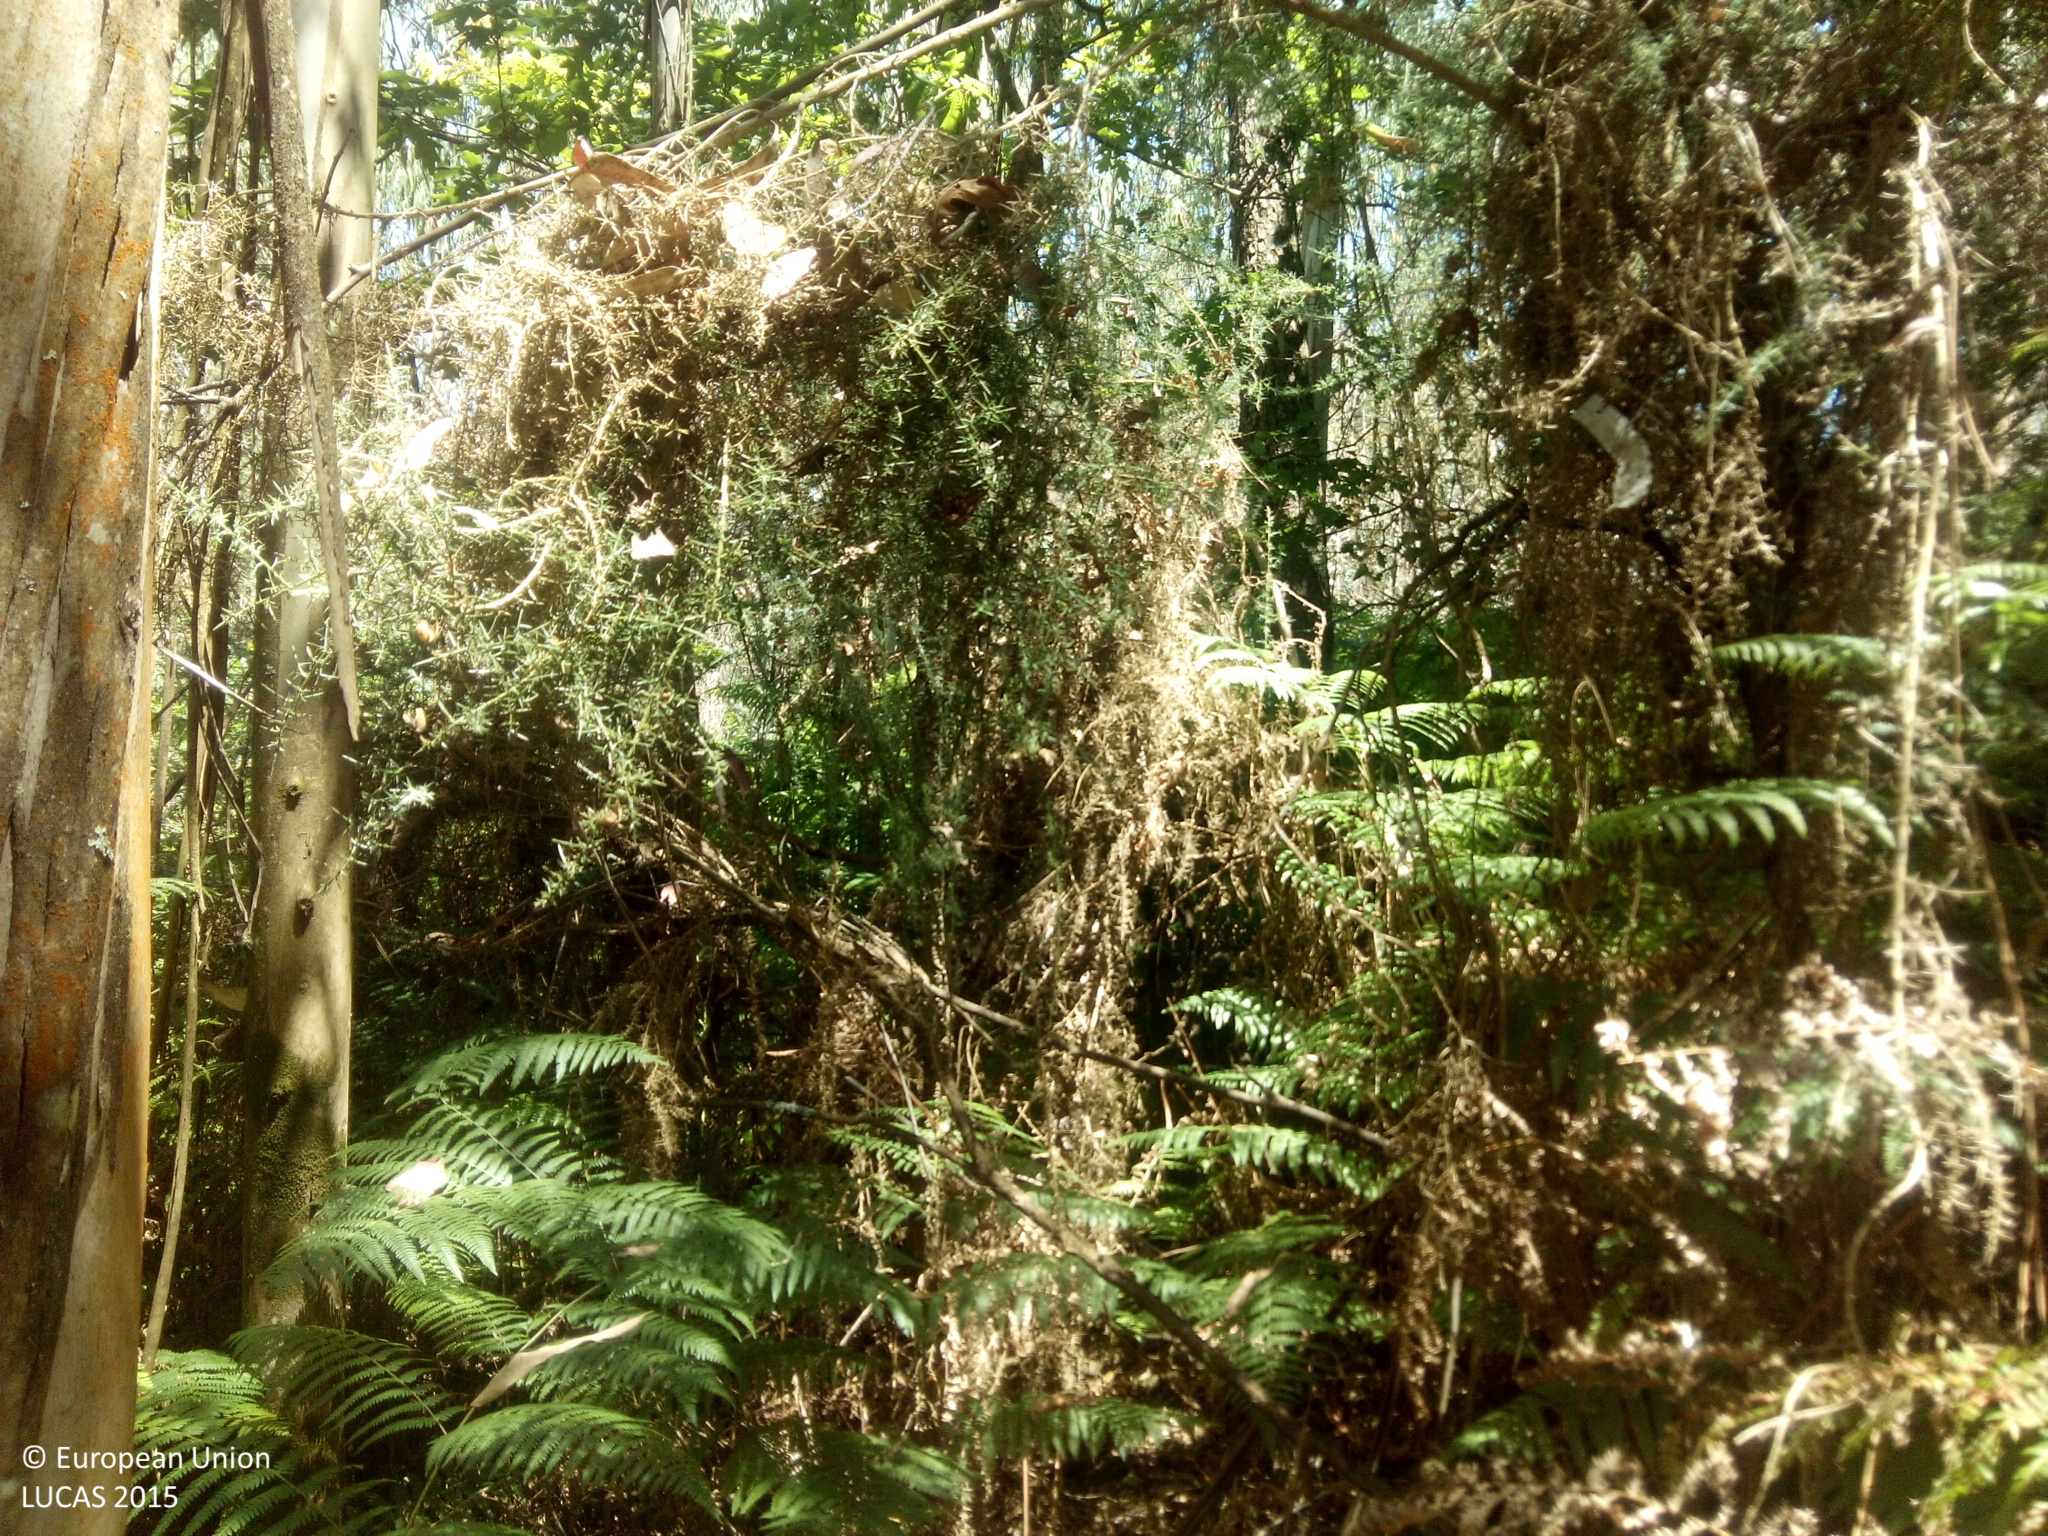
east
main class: Woodland
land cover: Broadleaved woodland
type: exotic forest
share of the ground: > 75 %
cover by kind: broadleaved forest trees 100 %
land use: Forestry
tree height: > 5 m
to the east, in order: Broadleaved woodland; Tracks; Pine dominated mixed woodland; Dry stone walls; Pine dominated mixed woodland; Broadleaved woodland; Pine dominated mixed woodland; Dry stone walls; Abandoned hedges; Paved roads, cycling and walking lanes; Ditches and canals; Artificial constructions; Pine dominated mixed woodland
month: June
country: ES
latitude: 42.7455
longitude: -8.3861
